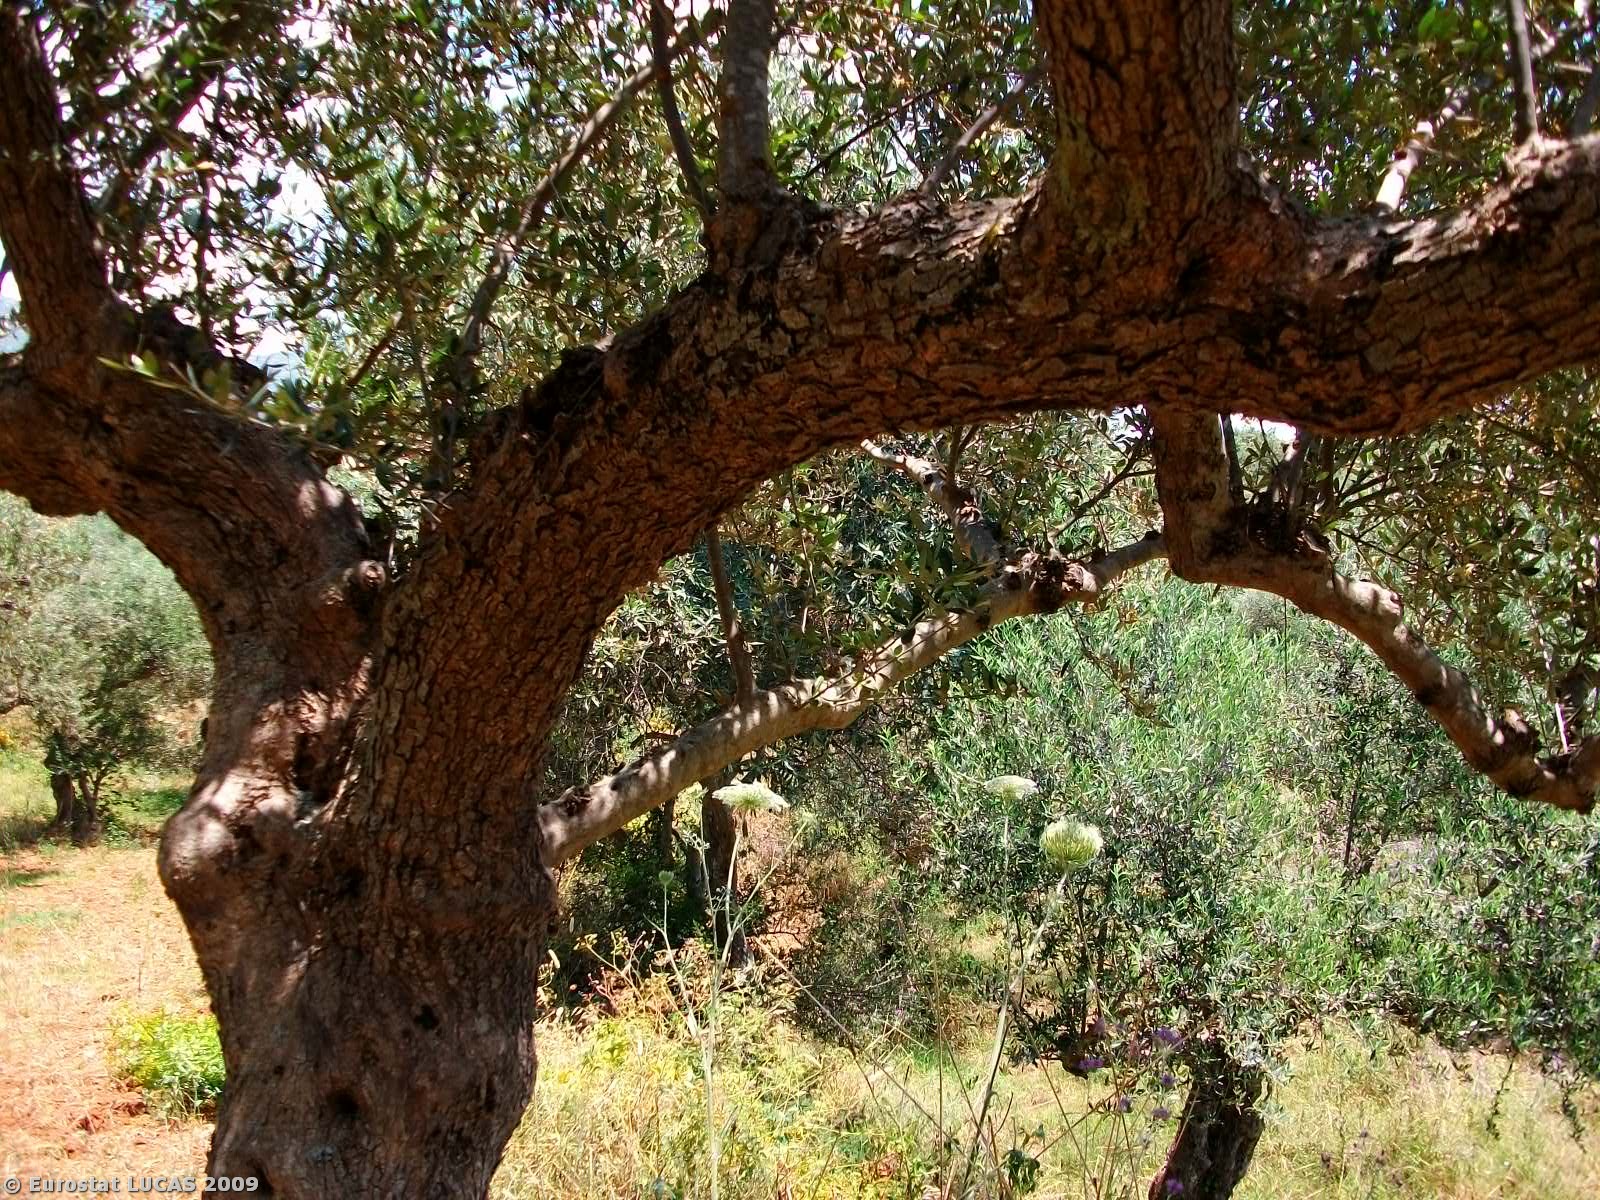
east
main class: Cropland
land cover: Olive groves
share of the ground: 50 - 75 %
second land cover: Grassland with sparse tree/shrub cover
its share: > 75 %
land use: Agriculture (excluding fallow land and kitchen gardens)
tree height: < 5 m
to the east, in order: Olive groves; Grassland with sparse tree/shrub cover; Dry stone walls; Single bushes/trees; Olive groves; Dry stone walls; Grass margins; Tracks; Shrubland with sparse tree cover; Tracks; Olive groves; Dry stone walls; Olive groves; Grassland with sparse tree/shrub cover
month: June
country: GR
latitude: 36.8570
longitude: 22.2783
